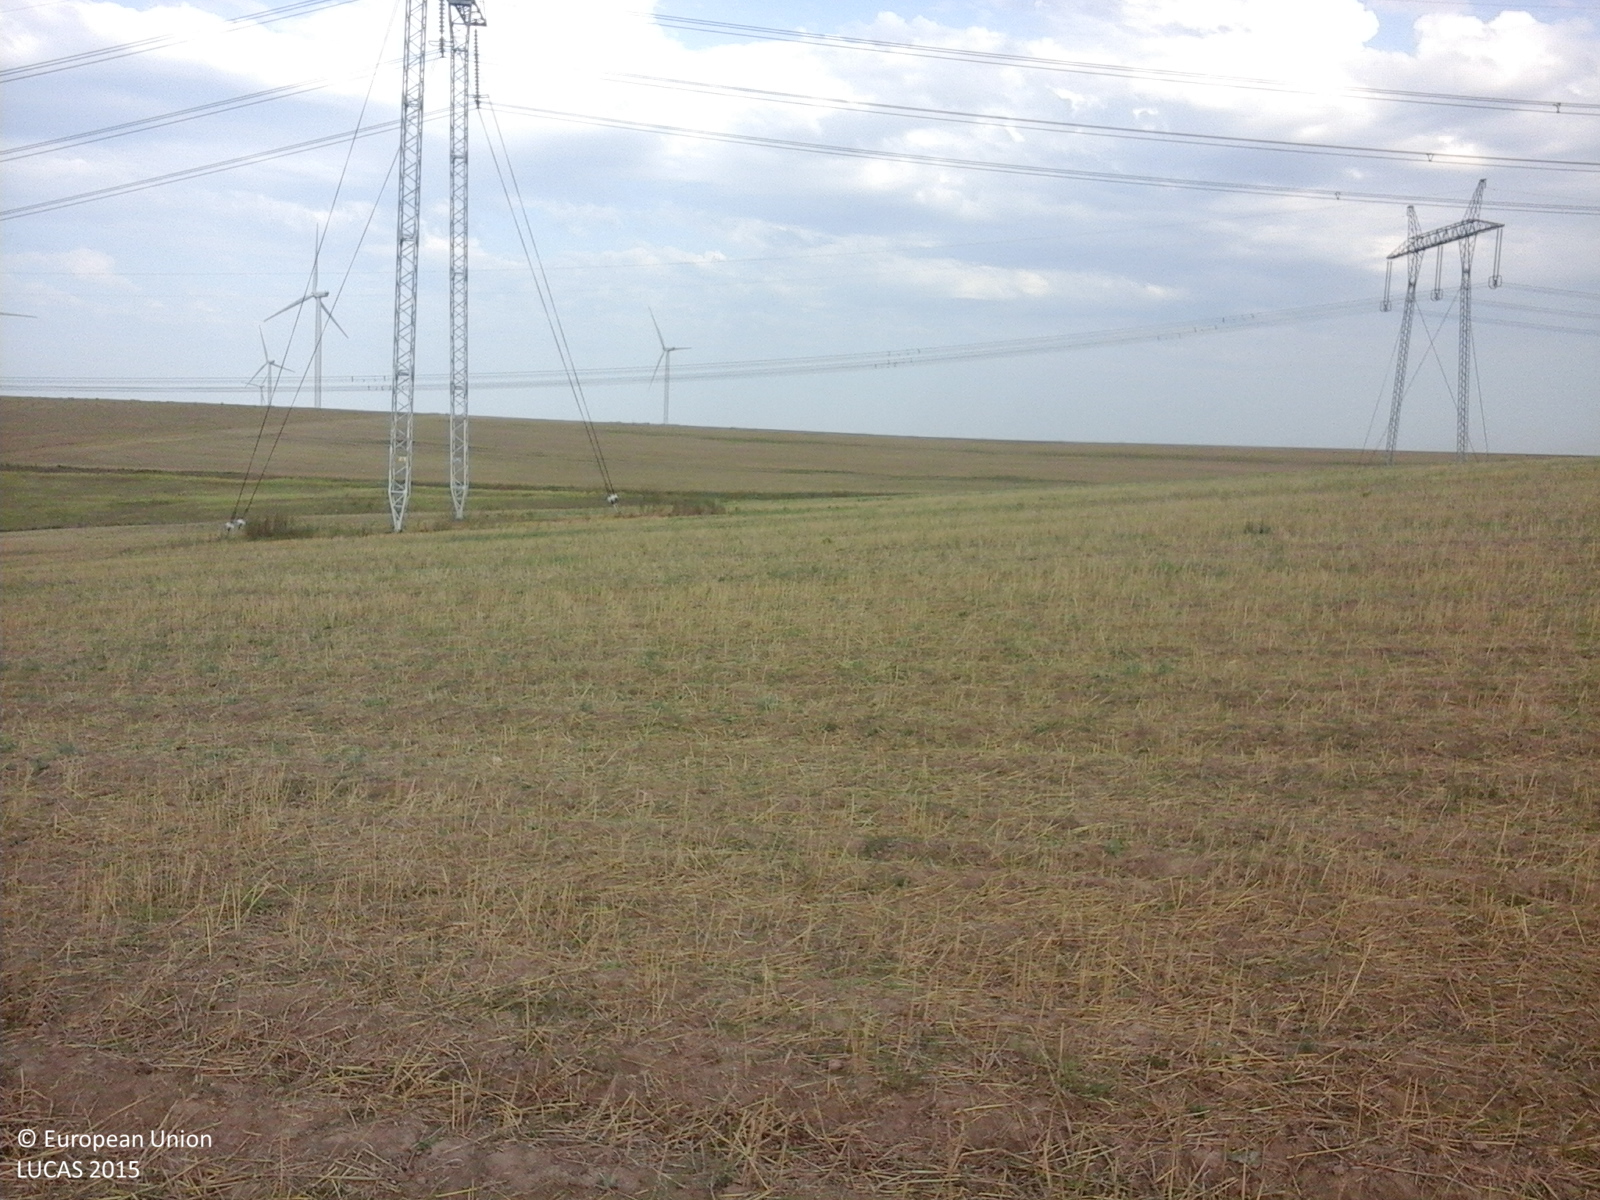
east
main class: Cropland
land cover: Common wheat
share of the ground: 25 - 50 %
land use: Agriculture (excluding fallow land and kitchen gardens)
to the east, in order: Common wheat; Electric lines; Common wheat; Spontaneously vegetated surfaces; Electric lines; Spontaneously vegetated surfaces
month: August
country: RO
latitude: 44.3763
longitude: 28.1458
